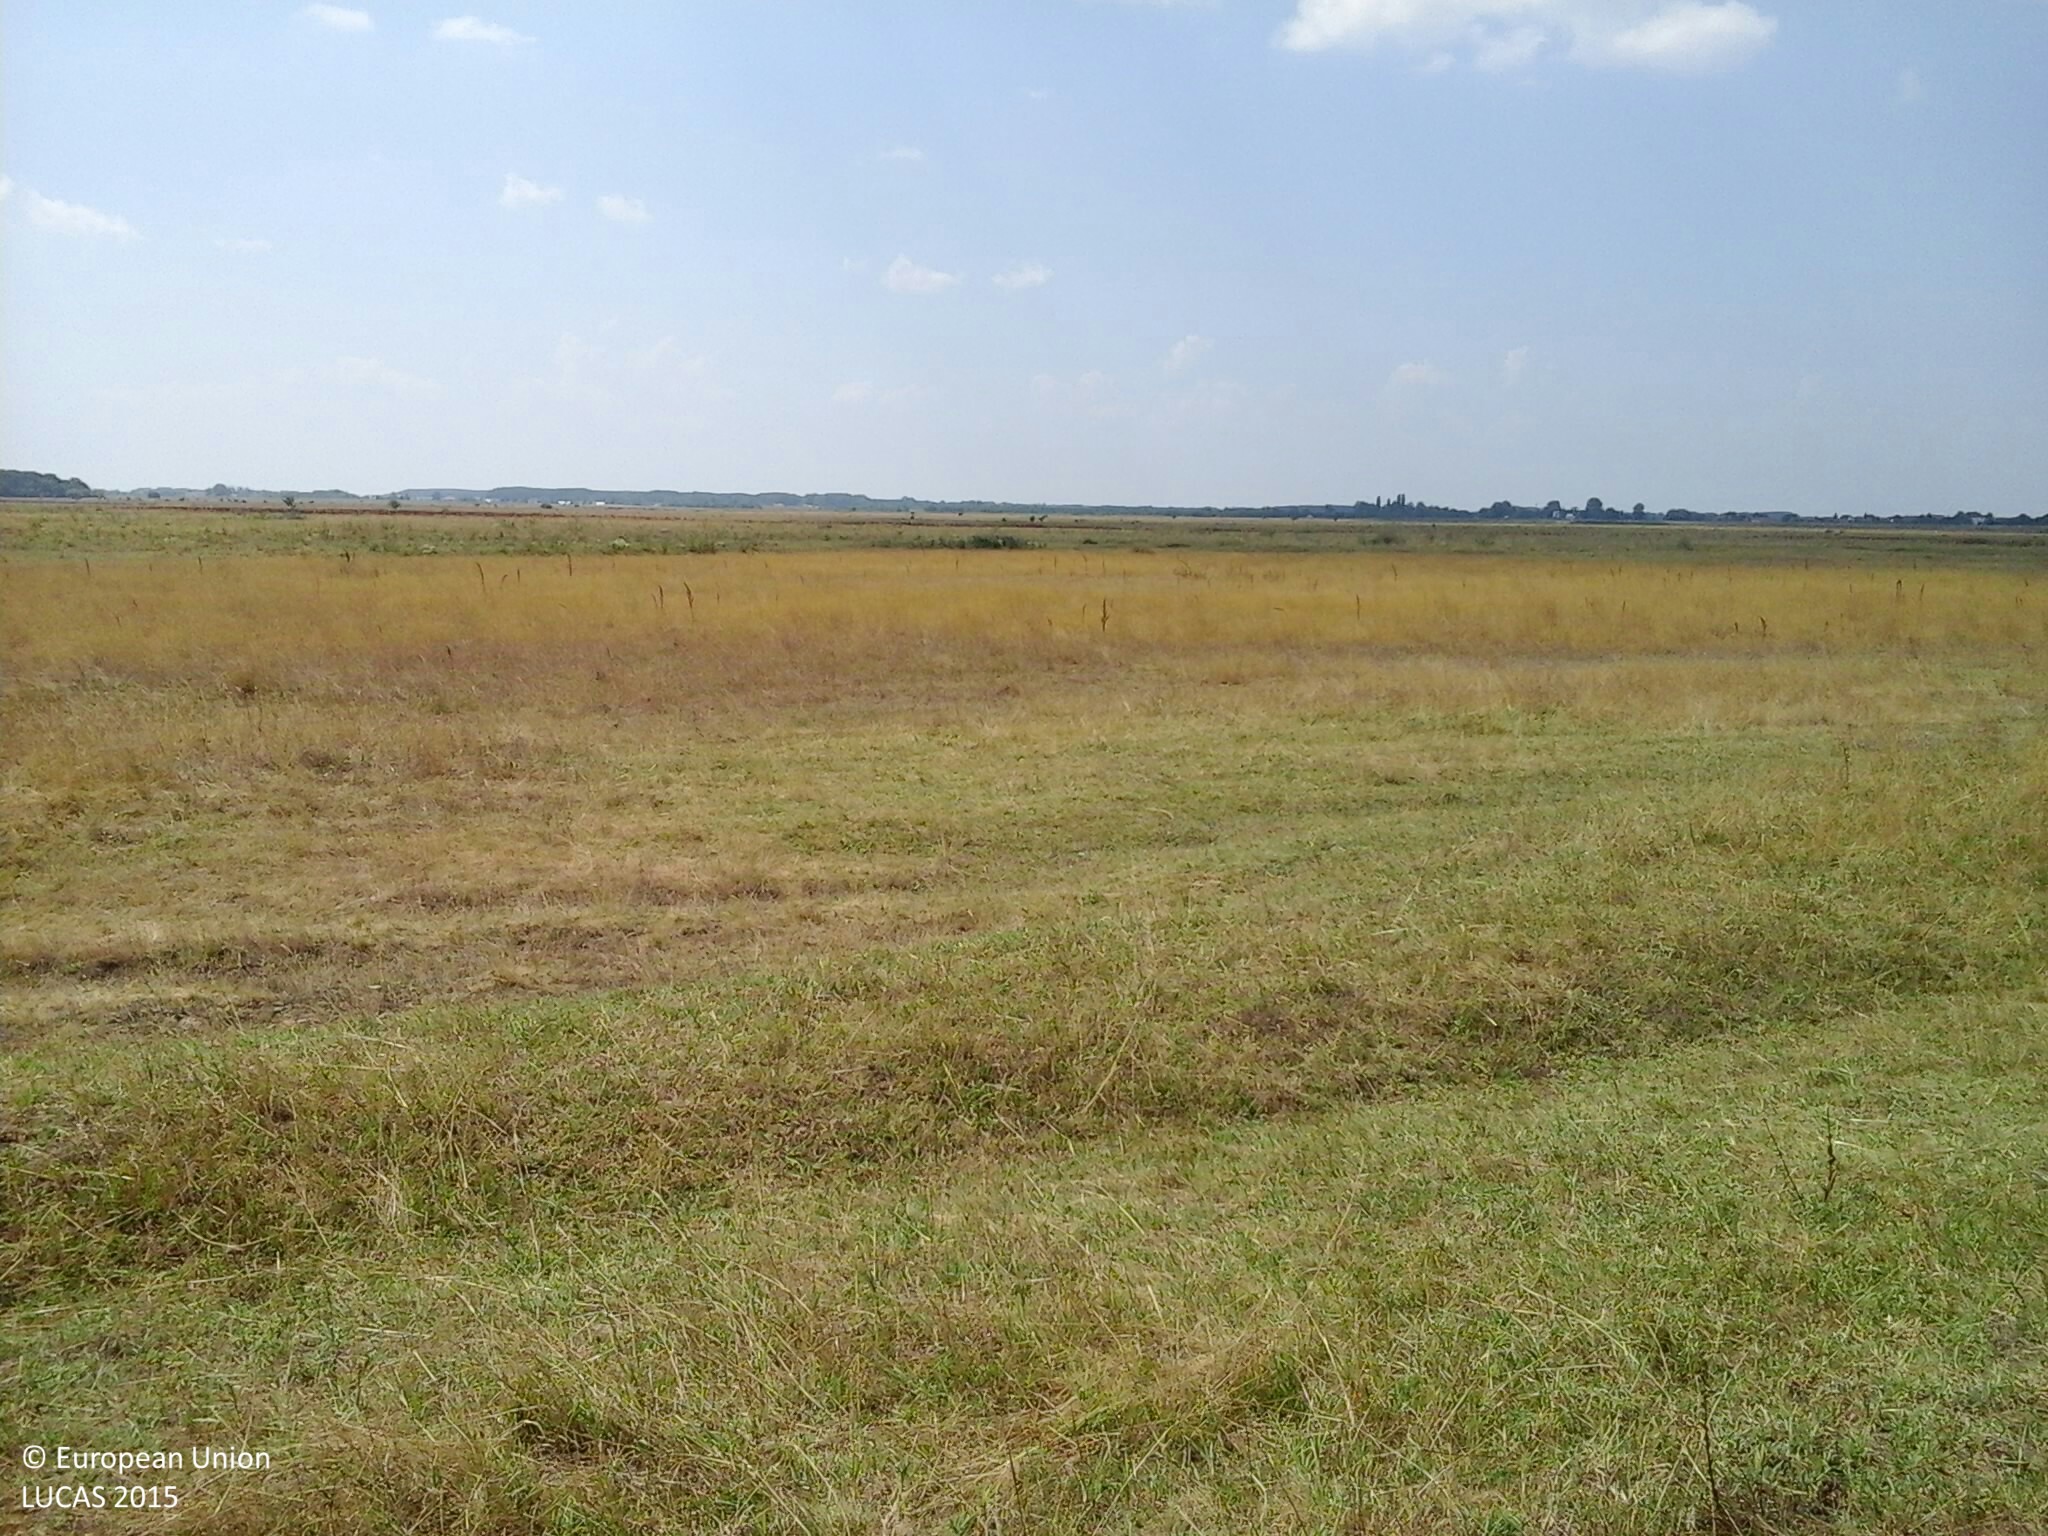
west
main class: Grassland
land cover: Grassland with sparse tree/shrub cover
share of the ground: > 75 %
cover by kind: herbaceous plants 90 %, broadleaved forest trees 5 %, shrubs 5 %
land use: Agriculture (excluding fallow land and kitchen gardens)
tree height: < 5 m
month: August
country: HU
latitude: 47.6083
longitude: 20.9042
